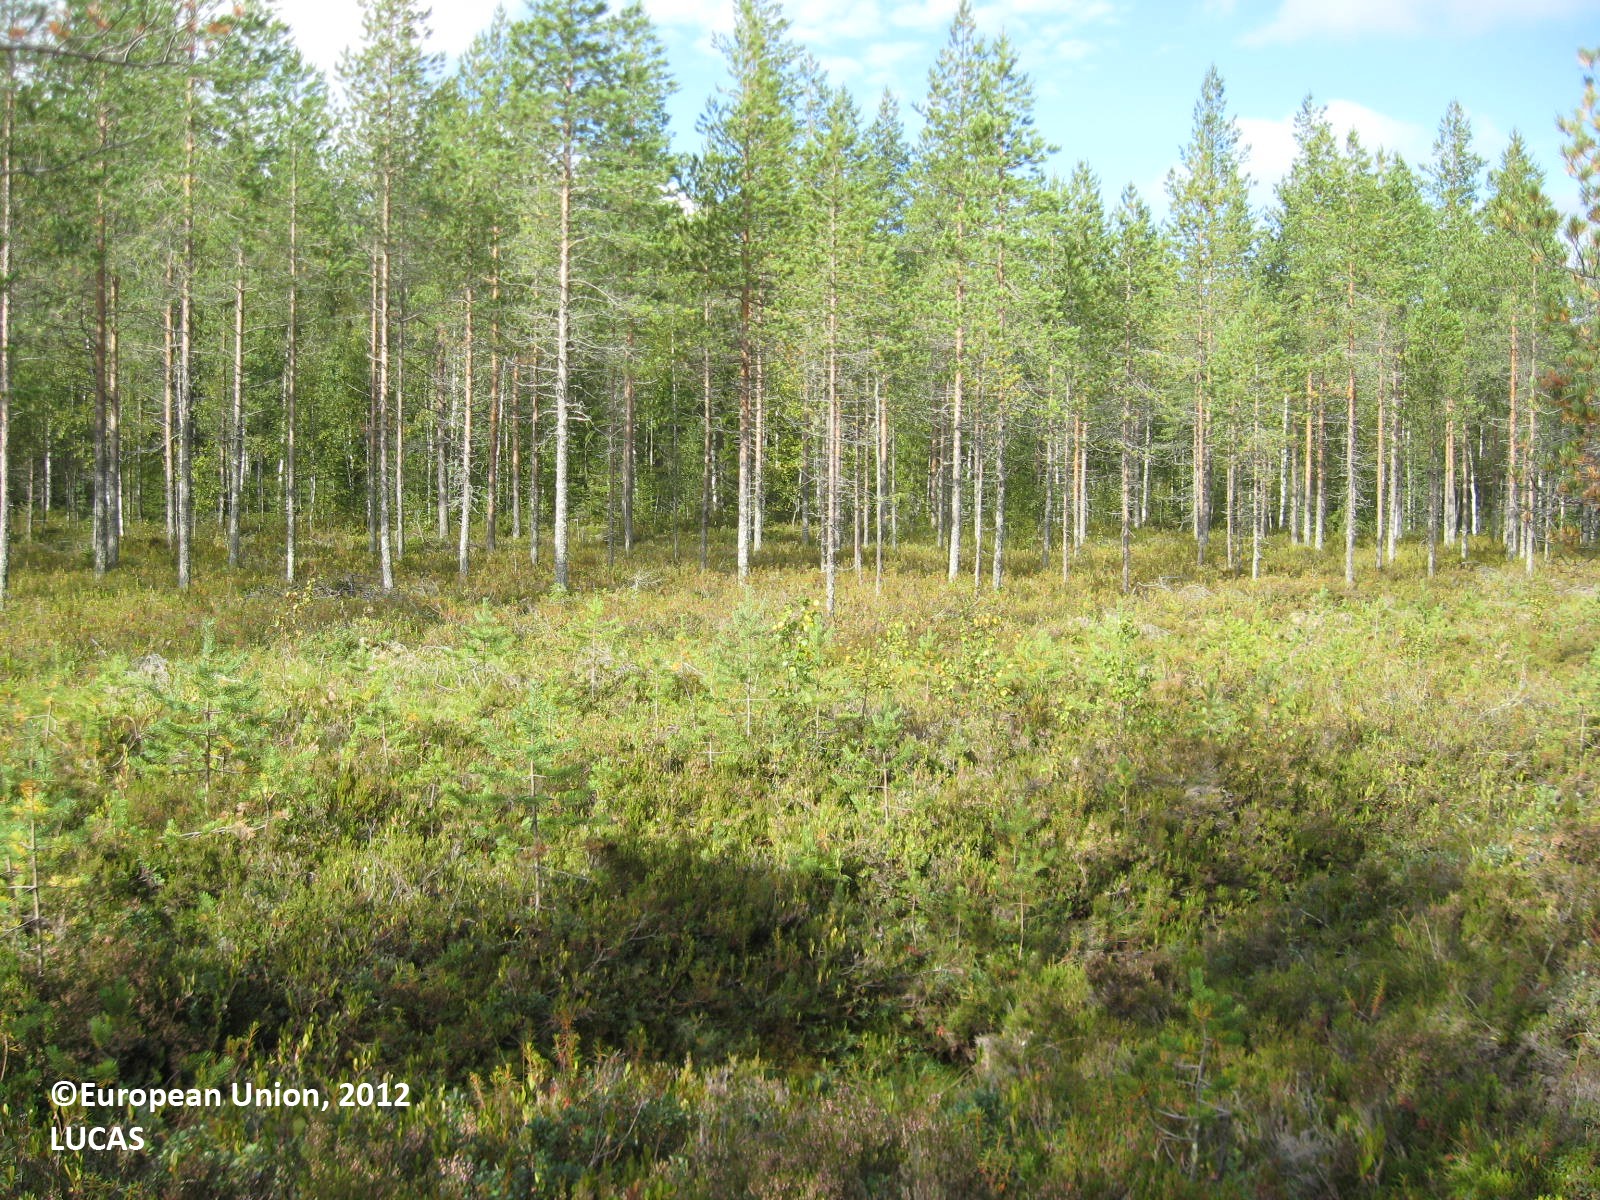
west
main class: Woodland
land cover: Pine dominated coniferous woodland
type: boreal forest
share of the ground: 25 - 50 %
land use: Forestry
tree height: > 5 m
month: August
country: FI
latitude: 63.5965
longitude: 29.5157
